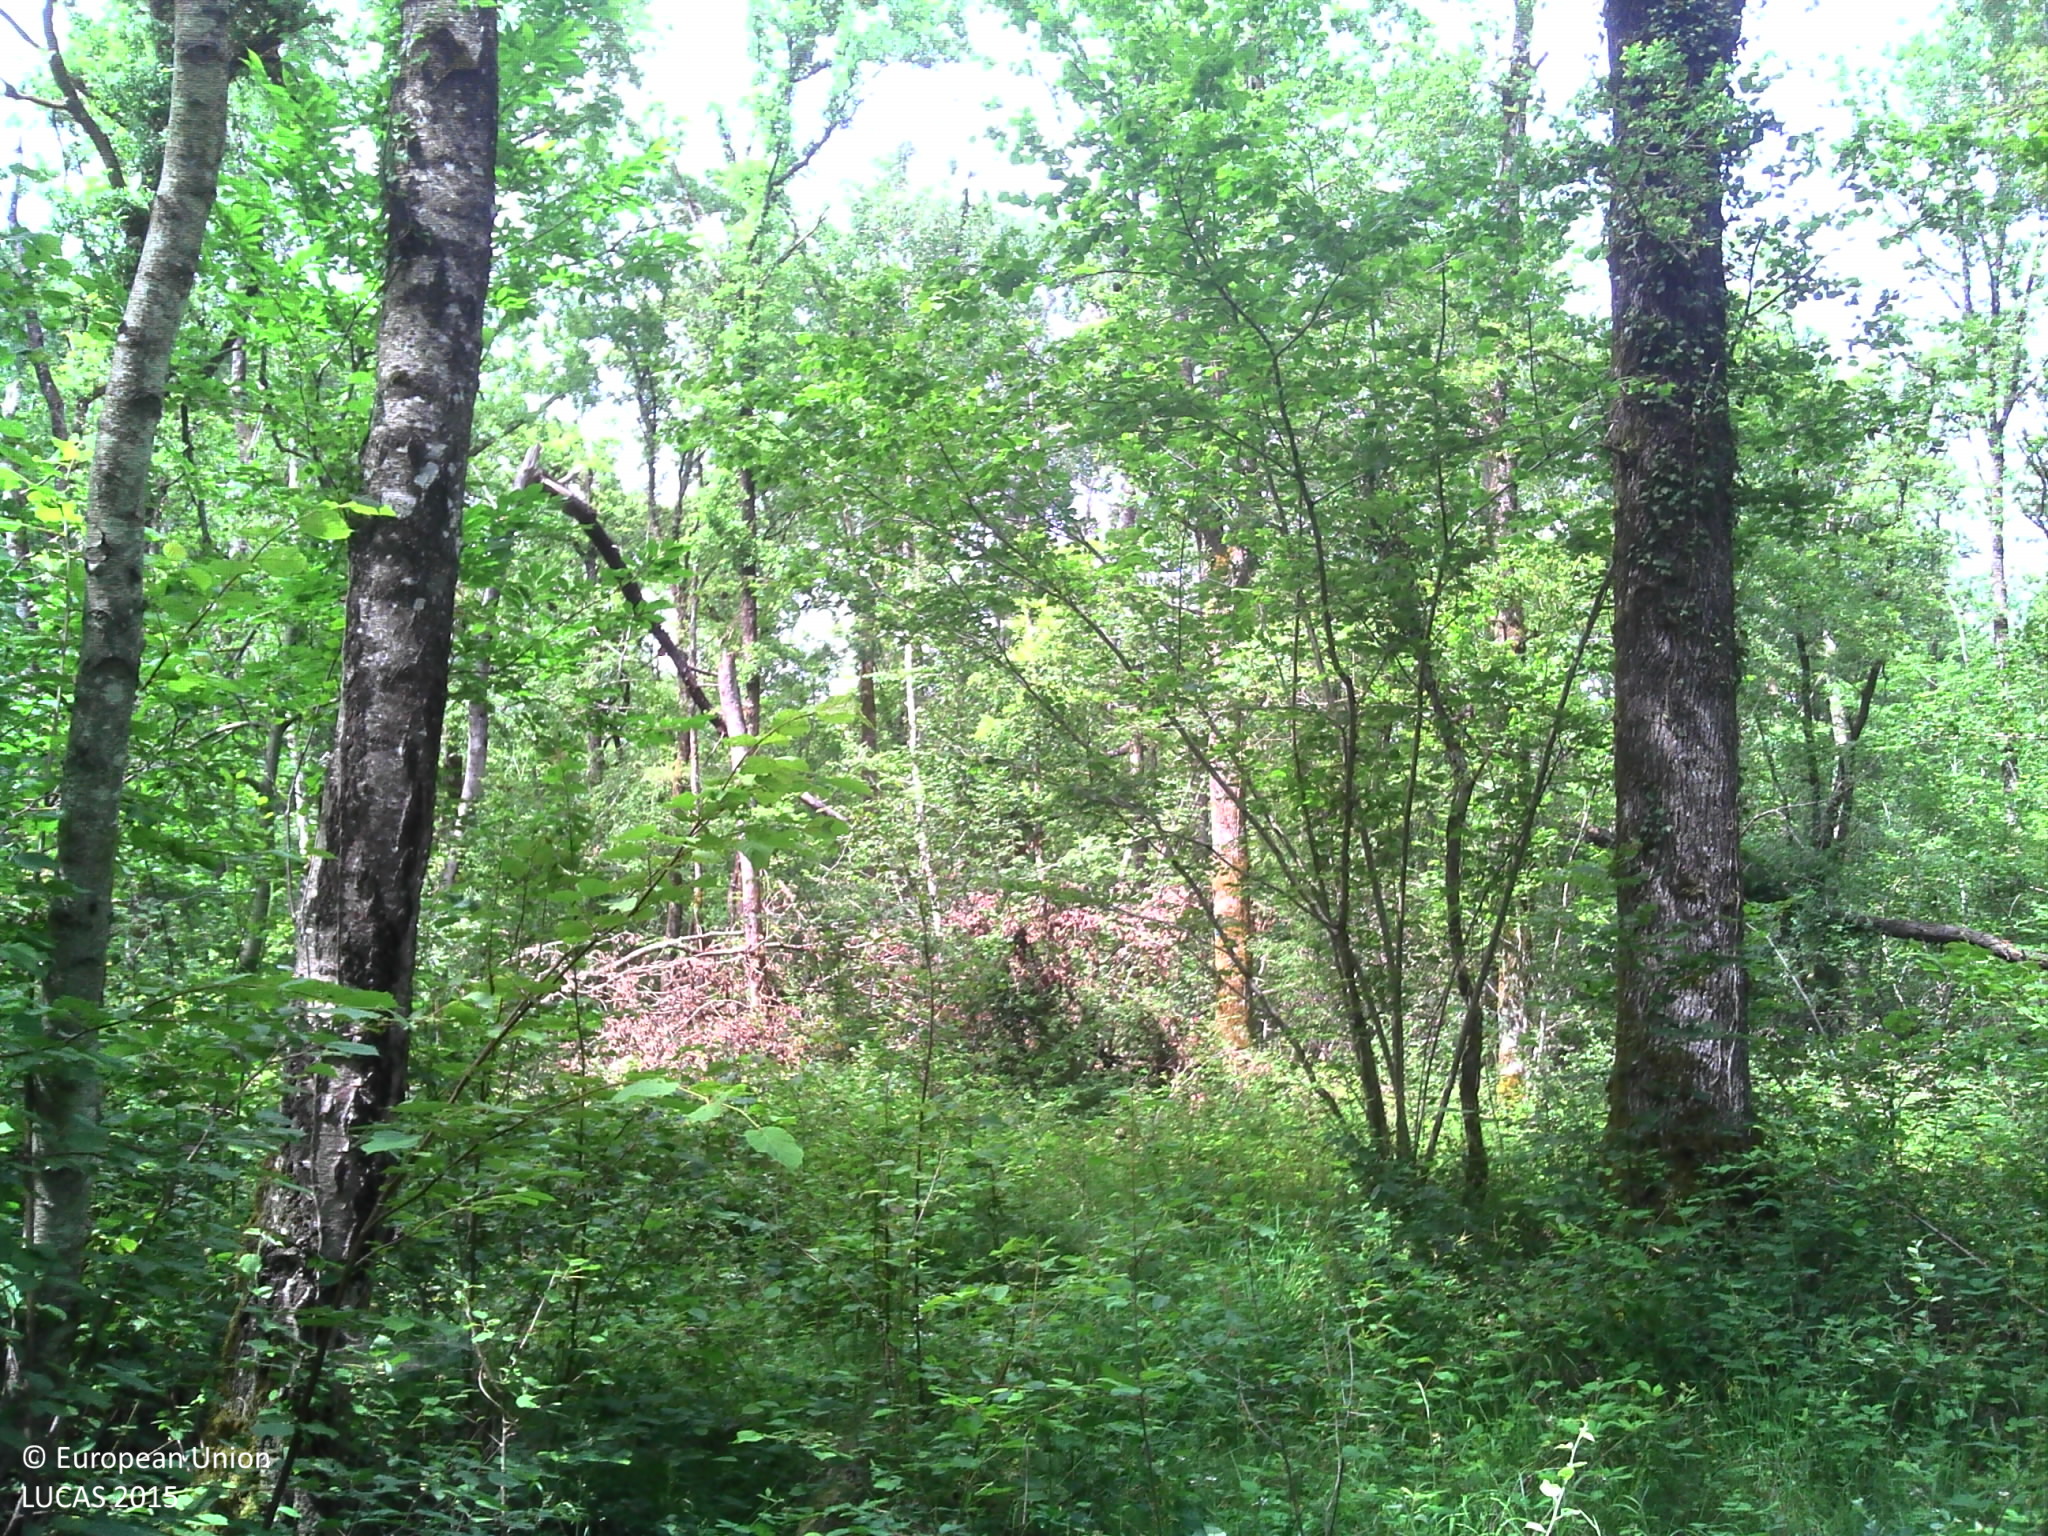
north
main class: Woodland
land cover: Broadleaved woodland
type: mesophytic deciduous forest
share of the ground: > 75 %
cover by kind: broadleaved forest trees 95 %, herbaceous plants 5 %
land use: Forestry
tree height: > 5 m
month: June
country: FR
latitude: 47.1139
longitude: 2.9707
